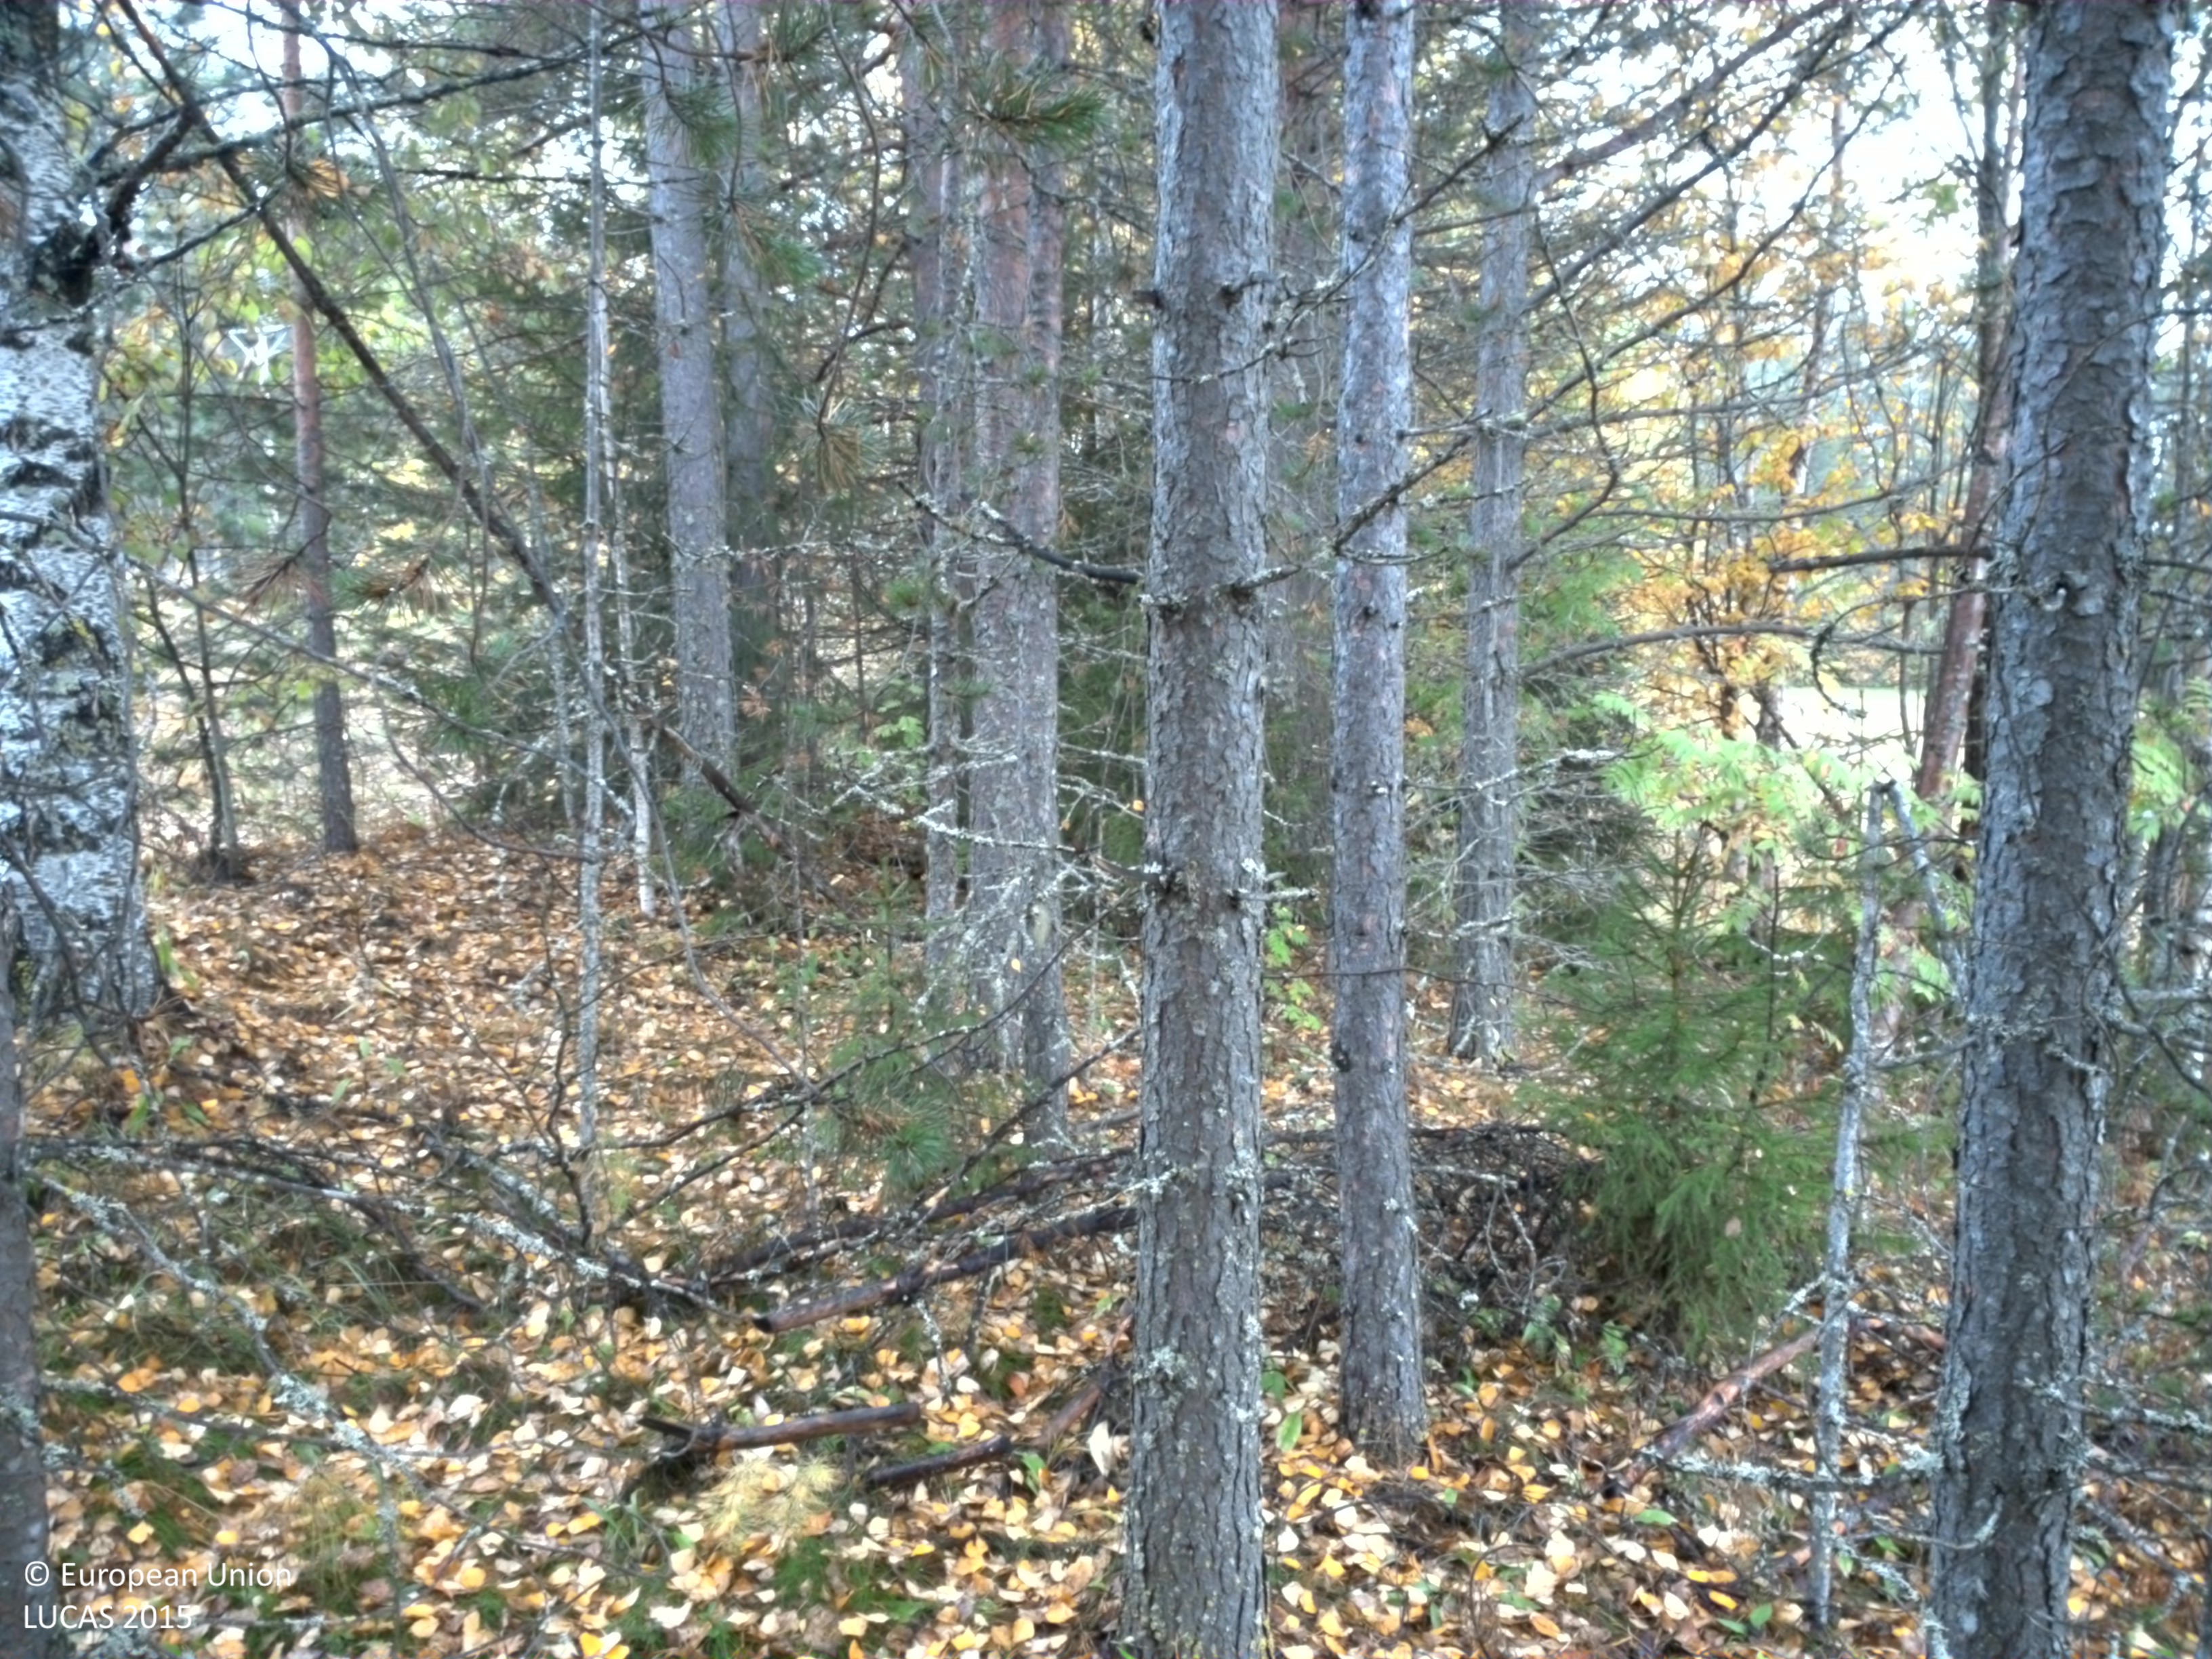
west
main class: Woodland
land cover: Pine dominated mixed woodland
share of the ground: 25 - 50 %
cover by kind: herbaceous plants 35 %, coniferous forest trees 25 %, shrubs 25 %, broadleaved forest trees 15 %
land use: Forestry
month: September
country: SE
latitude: 65.8479
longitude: 21.4692
